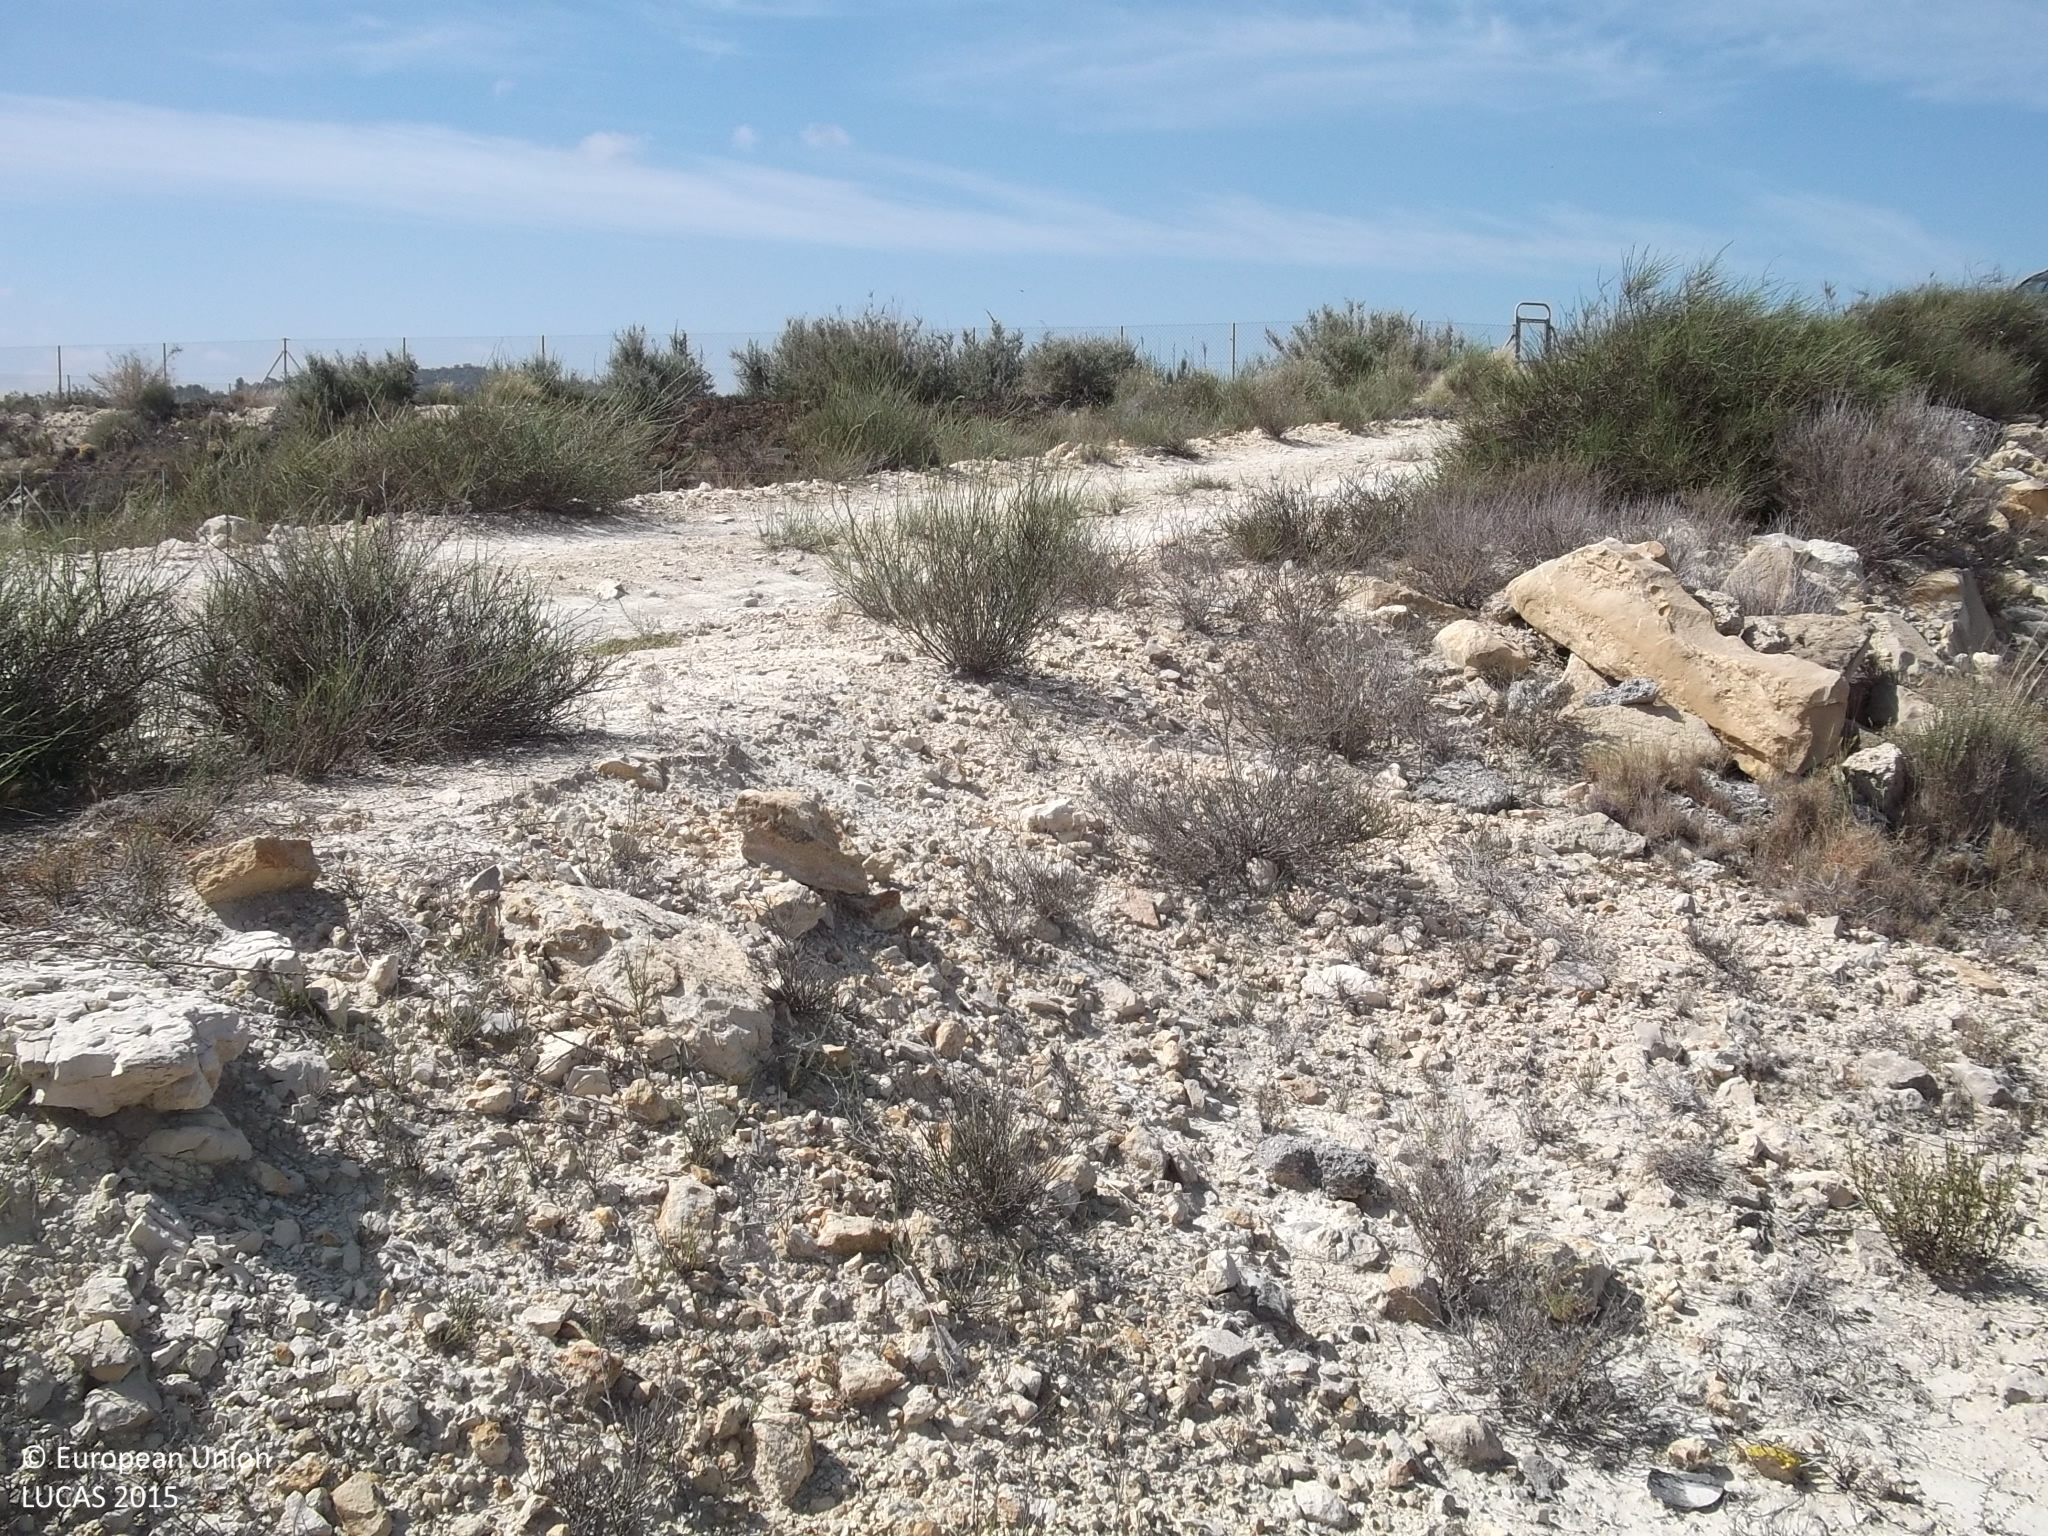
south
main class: Shrubland
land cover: Shrubland without tree cover
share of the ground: 25 - 50 %
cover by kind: shrubs 40 %, herbaceous plants 30 %, consolidated bare surface 30 %
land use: Semi-natural and natural areas not in use
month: May
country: ES
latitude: 37.9859
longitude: -0.8332
